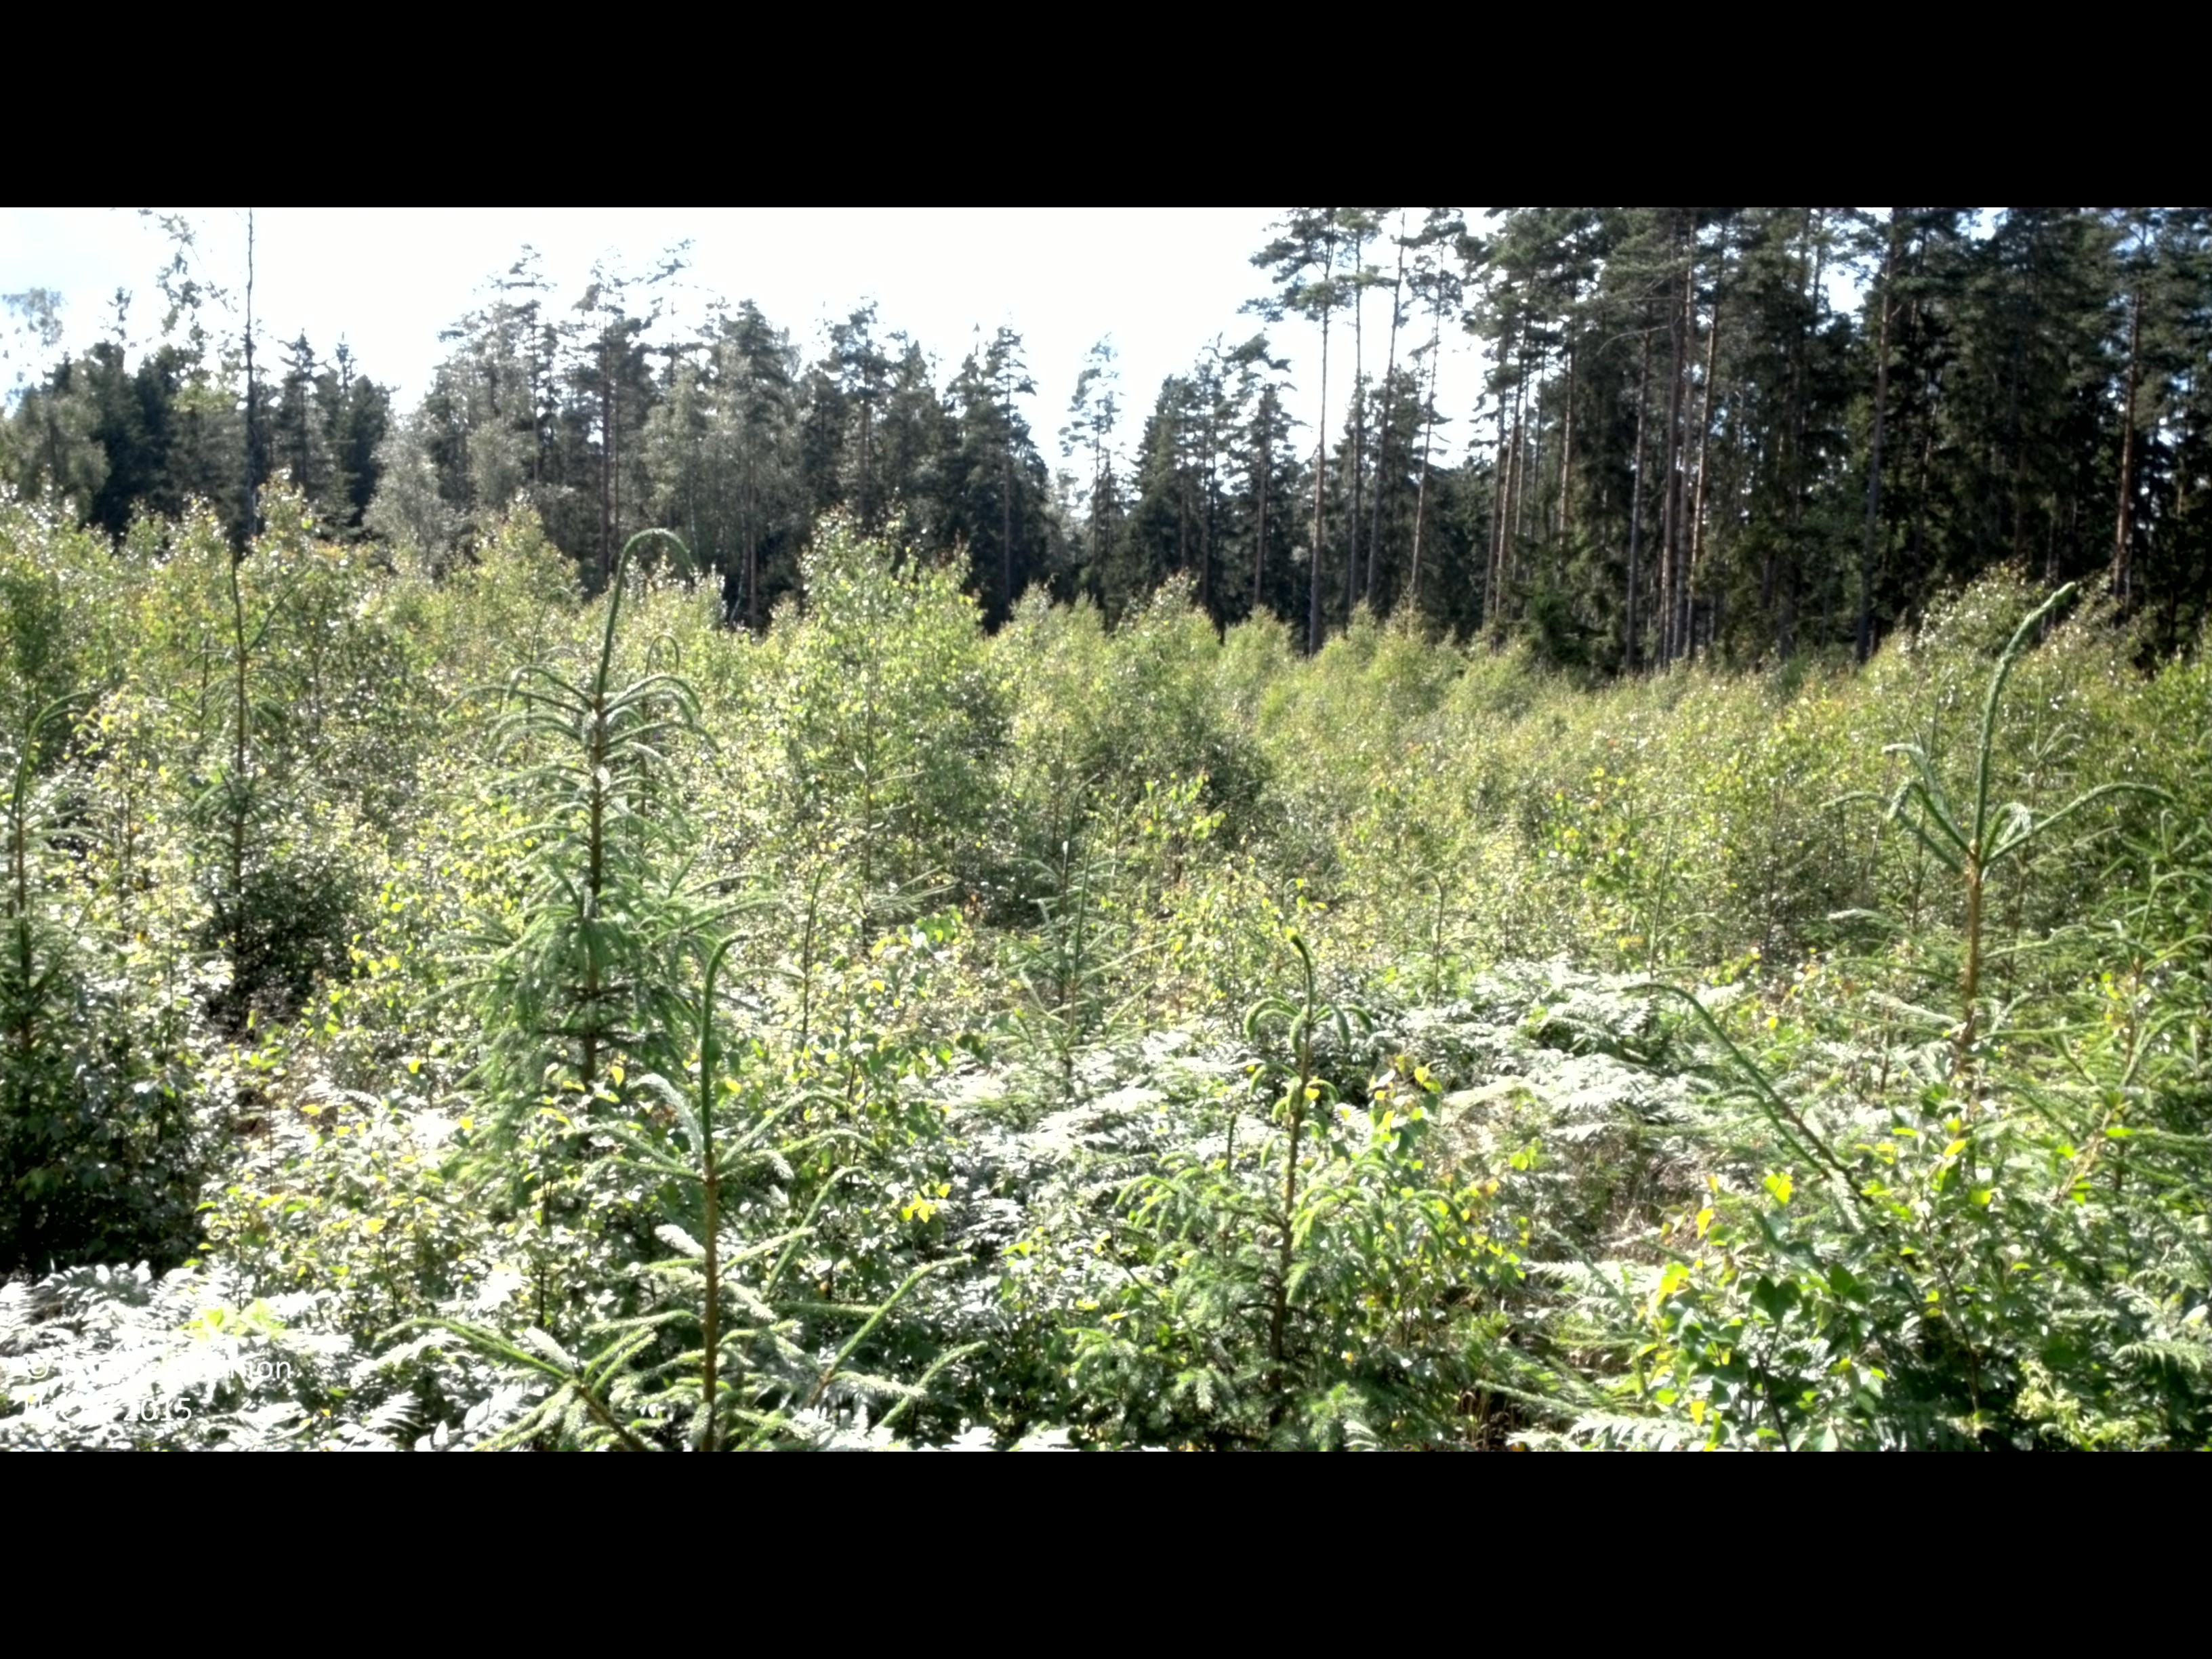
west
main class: Woodland
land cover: Broadleaved woodland
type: boreal forest
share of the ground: 50 - 75 %
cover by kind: broadleaved forest trees 55 %, herbaceous plants 20 %, coniferous forest trees 15 %, shrubs 10 %
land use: Forestry
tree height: < 5 m
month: July
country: SE
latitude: 56.4949
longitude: 14.2692
